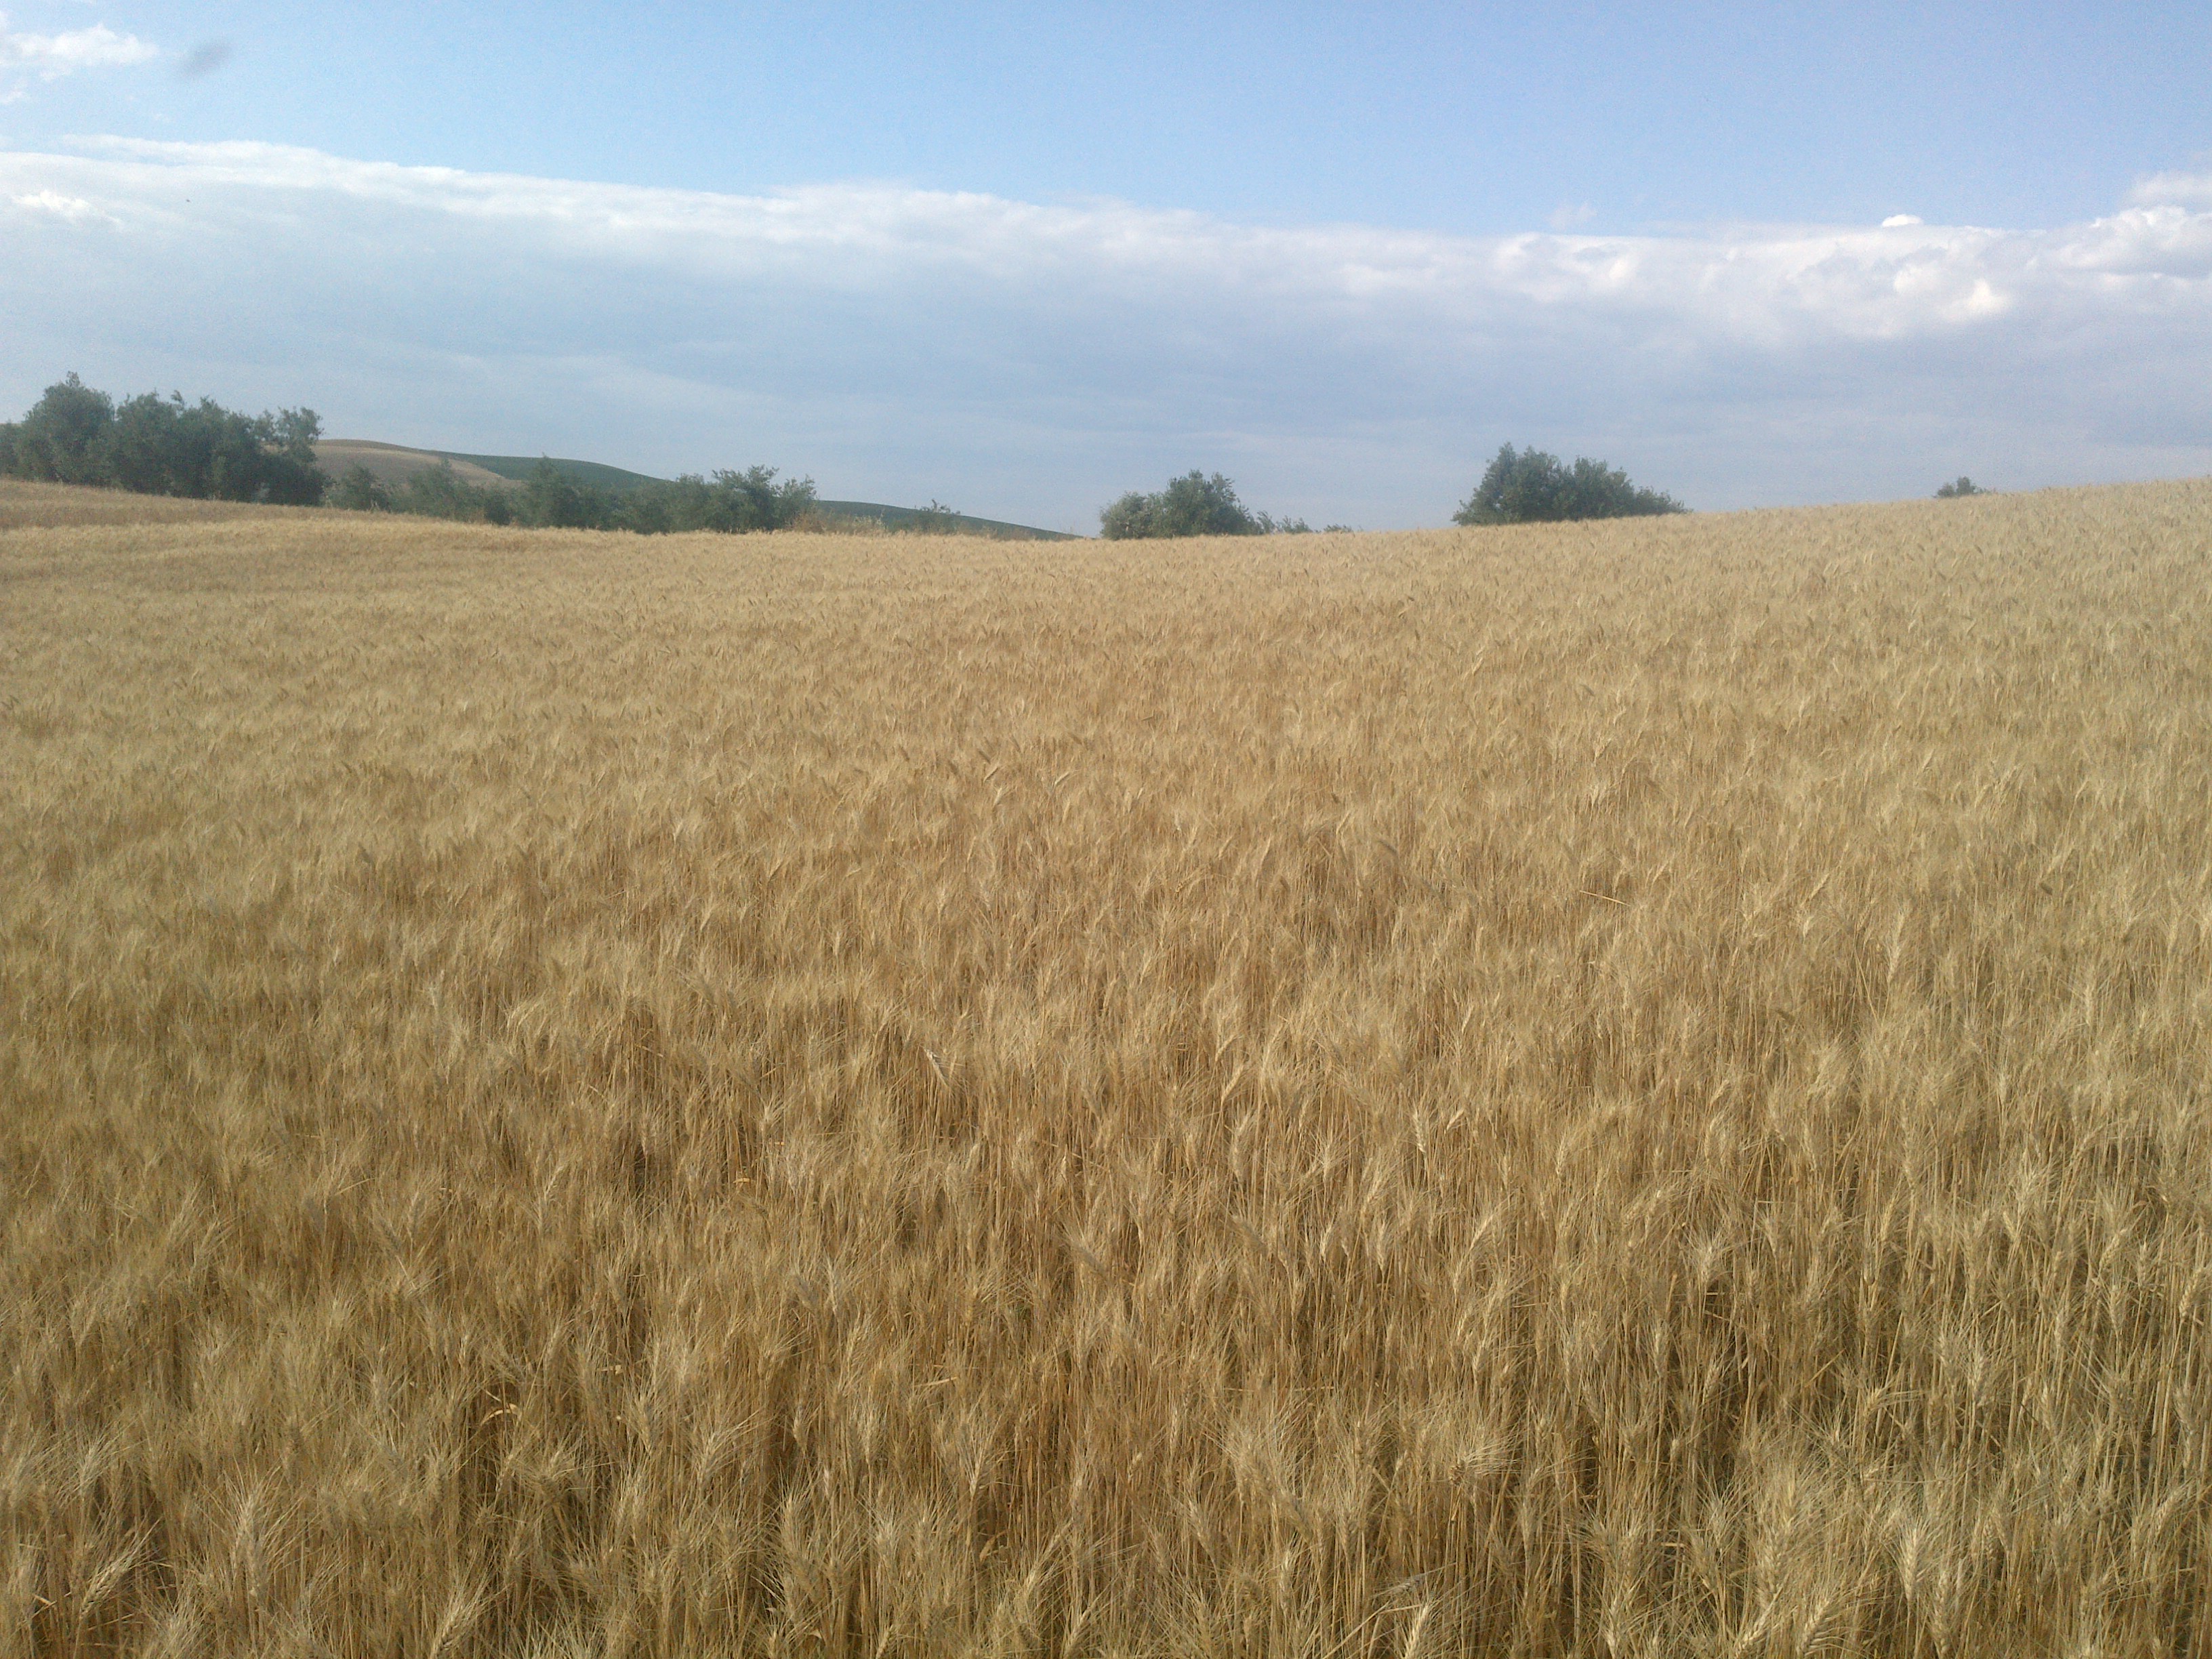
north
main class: Cropland
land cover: Durum wheat
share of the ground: > 75 %
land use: Agriculture (excluding fallow land and kitchen gardens)
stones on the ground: 10 - 25 %
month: May
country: ES
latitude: 37.7722
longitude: -4.4836
